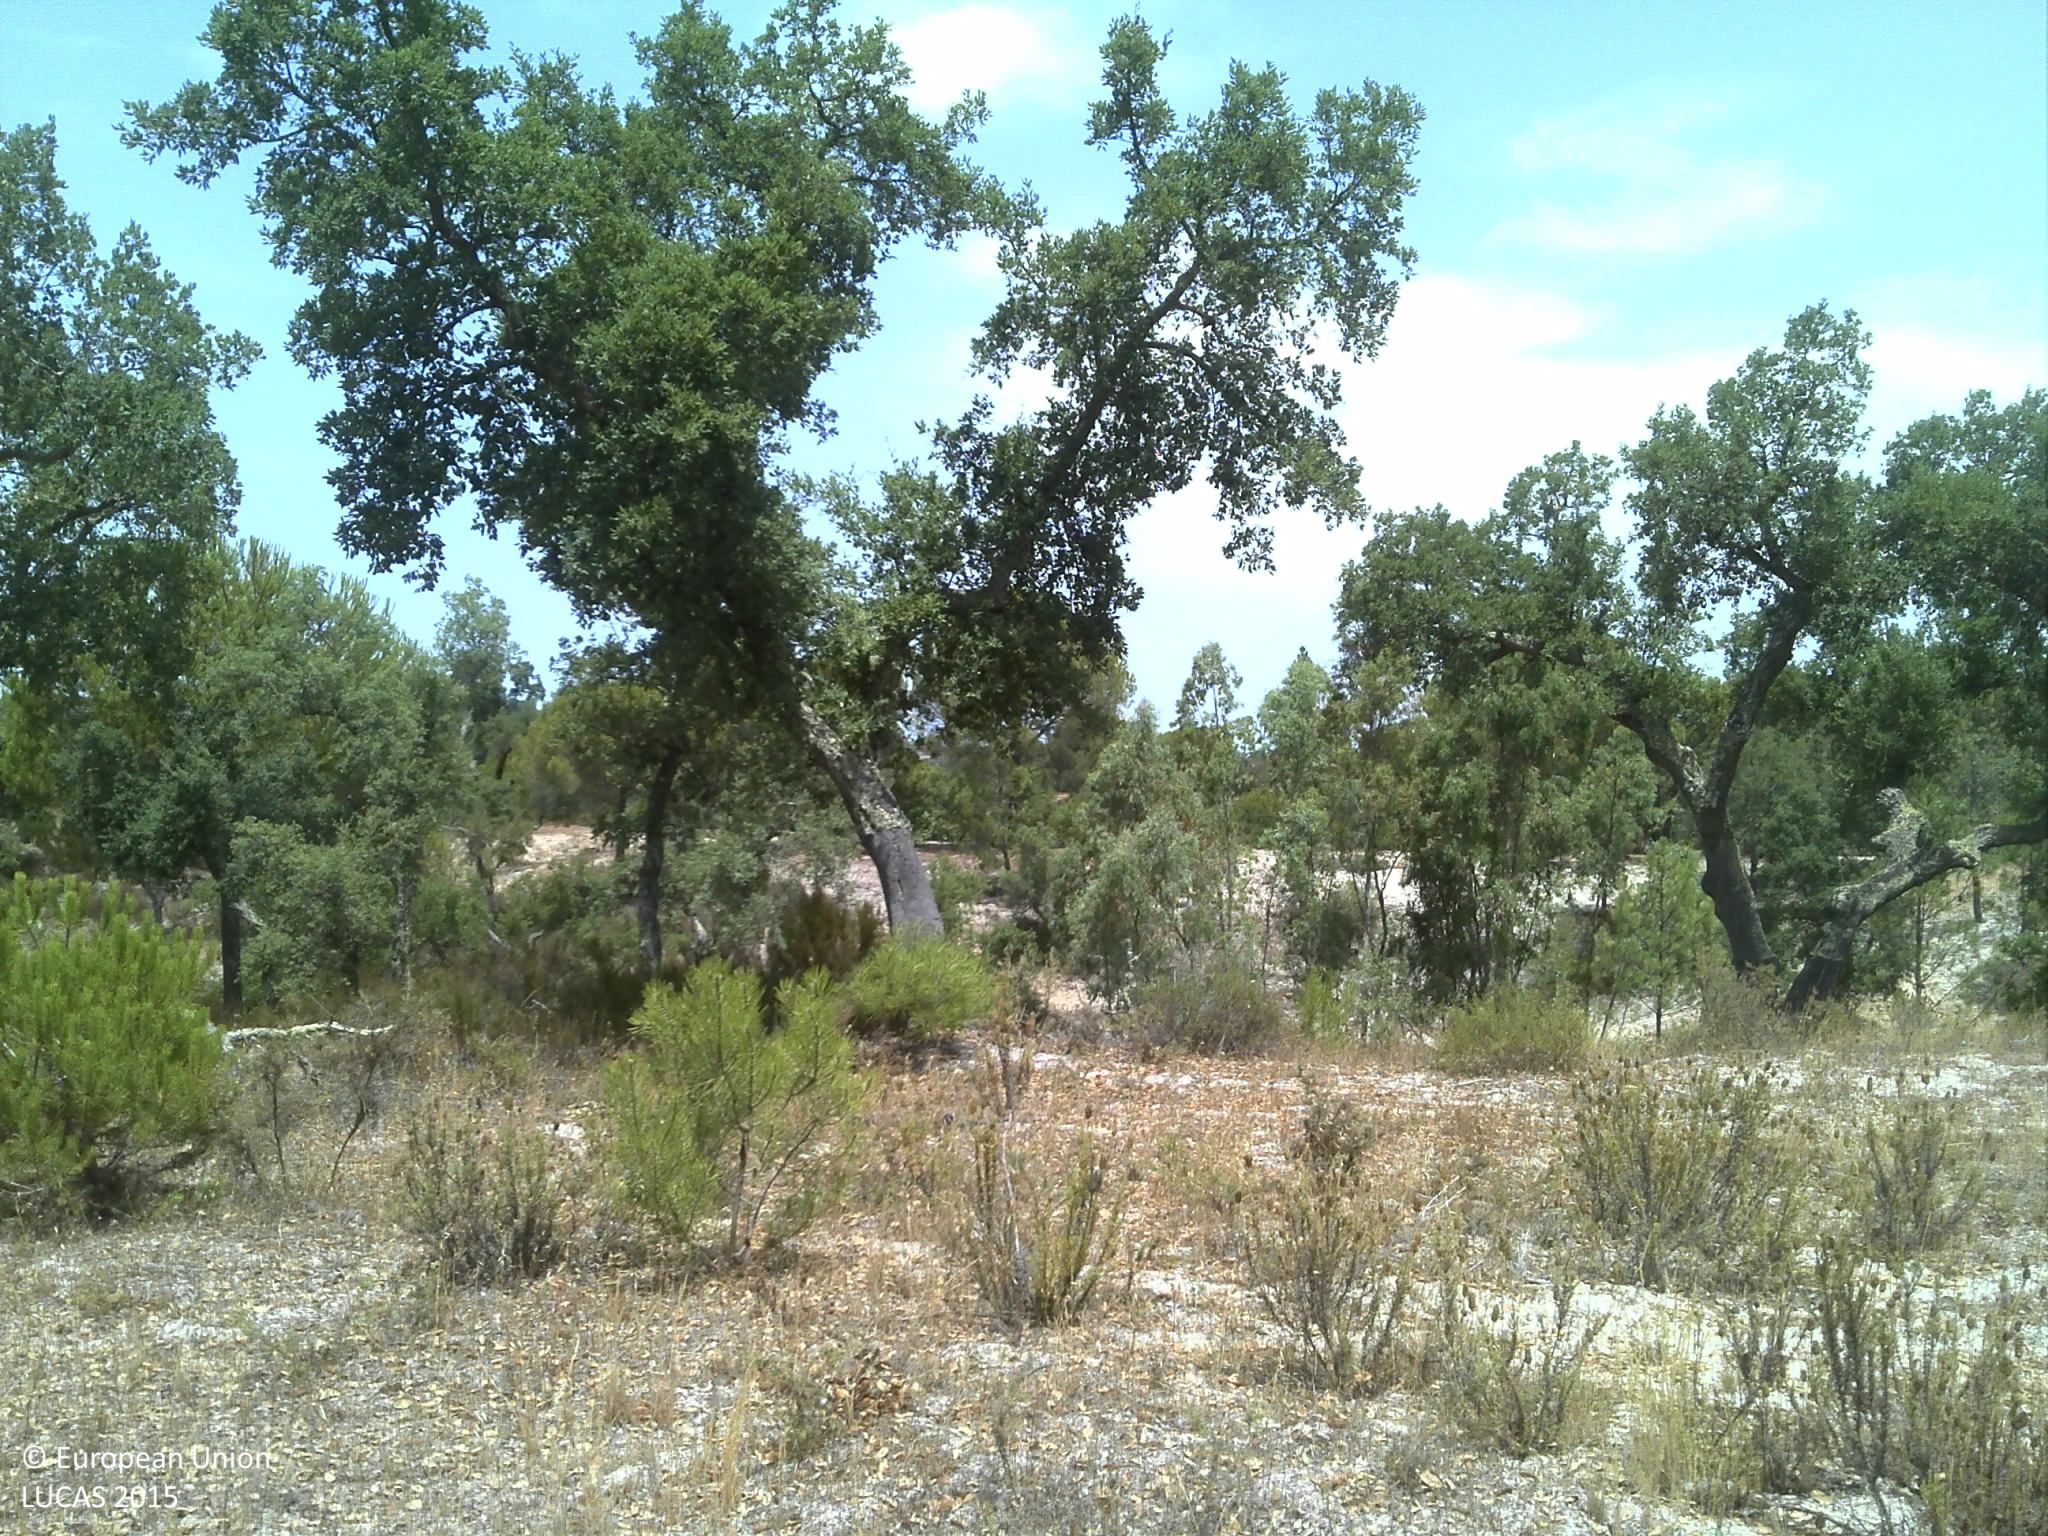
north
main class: Woodland
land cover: Broadleaved woodland
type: broadleaved evergreen forest
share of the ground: 25 - 50 %
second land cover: Grassland without tree/shrub cover
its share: 25 - 50 %
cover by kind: broadleaved forest trees 35 %, herbaceous plants 35 %, unconsolidated bare surface 30 %
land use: Forestry
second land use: Agriculture (excluding fallow land and kitchen gardens)
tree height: > 5 m
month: July
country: PT
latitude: 39.1518
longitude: -8.2376
